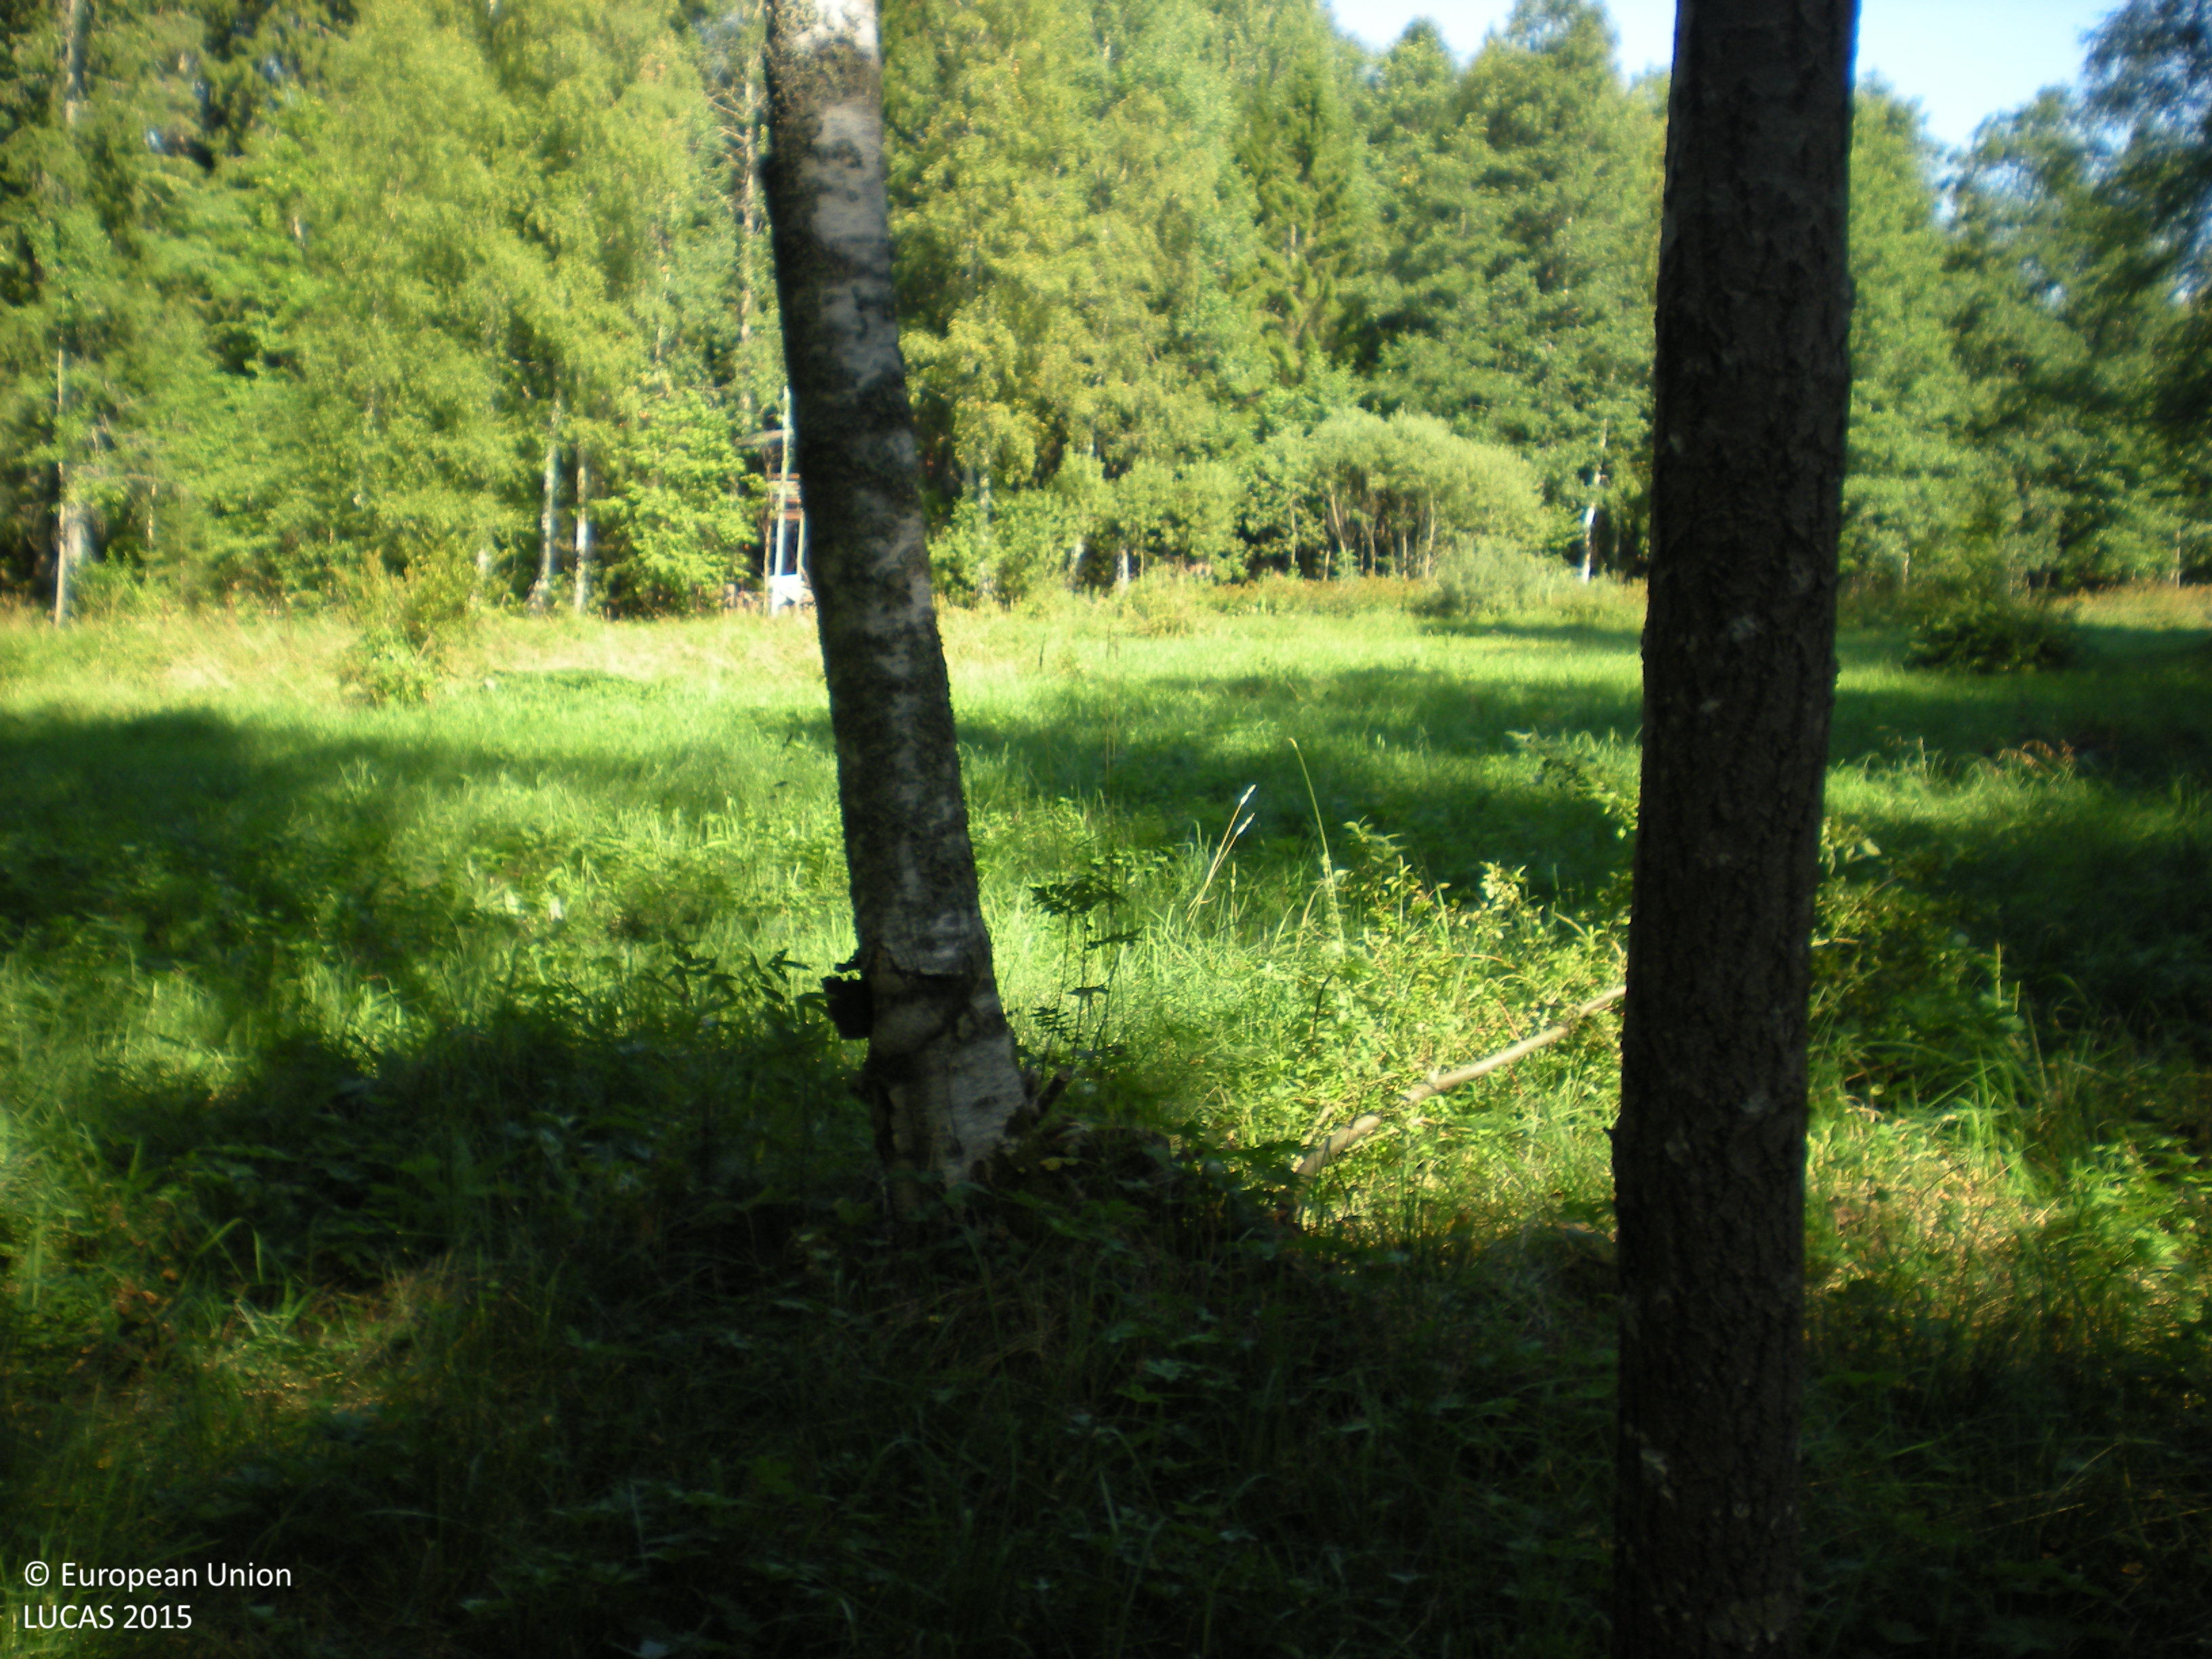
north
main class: Woodland
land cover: Broadleaved woodland
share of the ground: 25 - 50 %
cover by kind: broadleaved forest trees 40 %, herbaceous plants 40 %, coniferous forest trees 10 %, shrubs 5 %, lichens and mosses 5 %
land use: Forestry
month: August
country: SE
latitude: 60.6201
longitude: 17.3906
